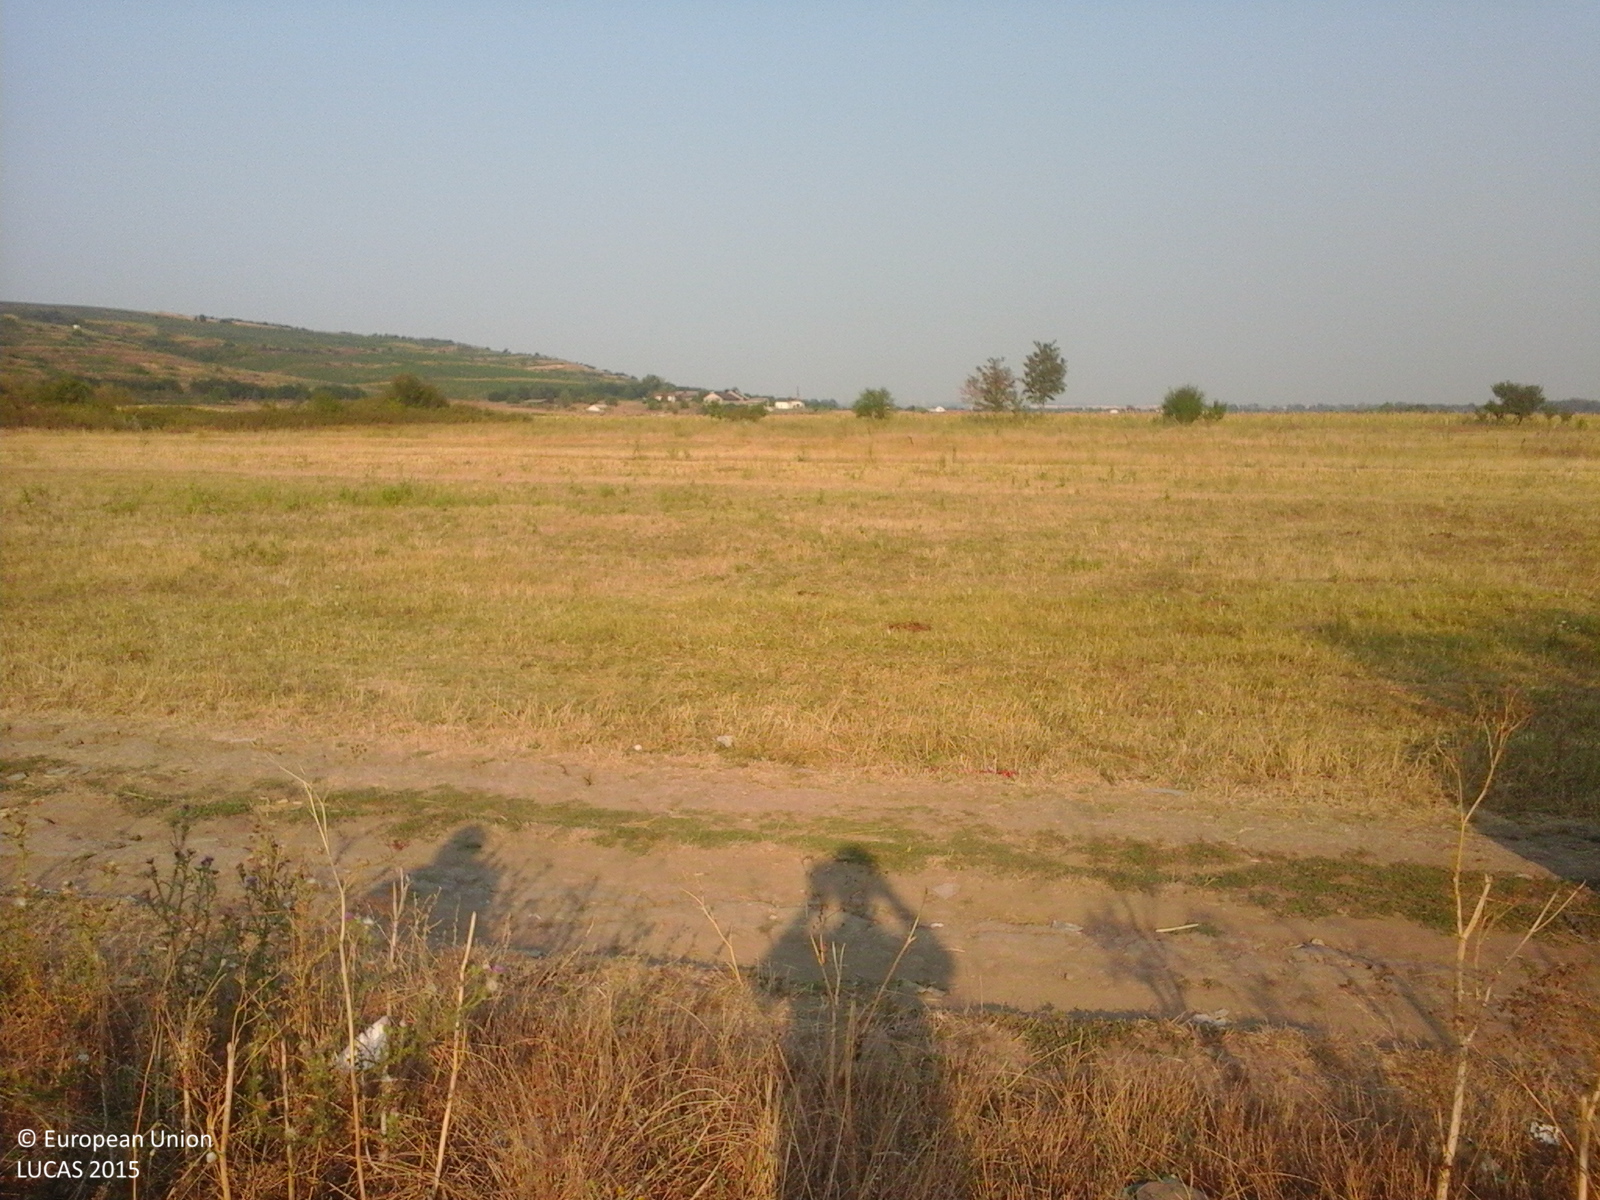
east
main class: Cropland
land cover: Maize
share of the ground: > 75 %
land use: Agriculture (excluding fallow land and kitchen gardens)
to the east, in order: Maize; Fences; Spontaneously vegetated surfaces; Tracks; Grassland without tree/shrub cover; Common wheat; Grassland without tree/shrub cover; Common wheat; Grassland without tree/shrub cover; Common wheat; Spontaneously vegetated surfaces; Grassland without tree/shrub cover; Spontaneously vegetated surfaces; Grassland without tree/shrub cover; Ditches and canals; Grass margins; Maize
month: August
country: RO
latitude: 44.3549
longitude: 23.6672
